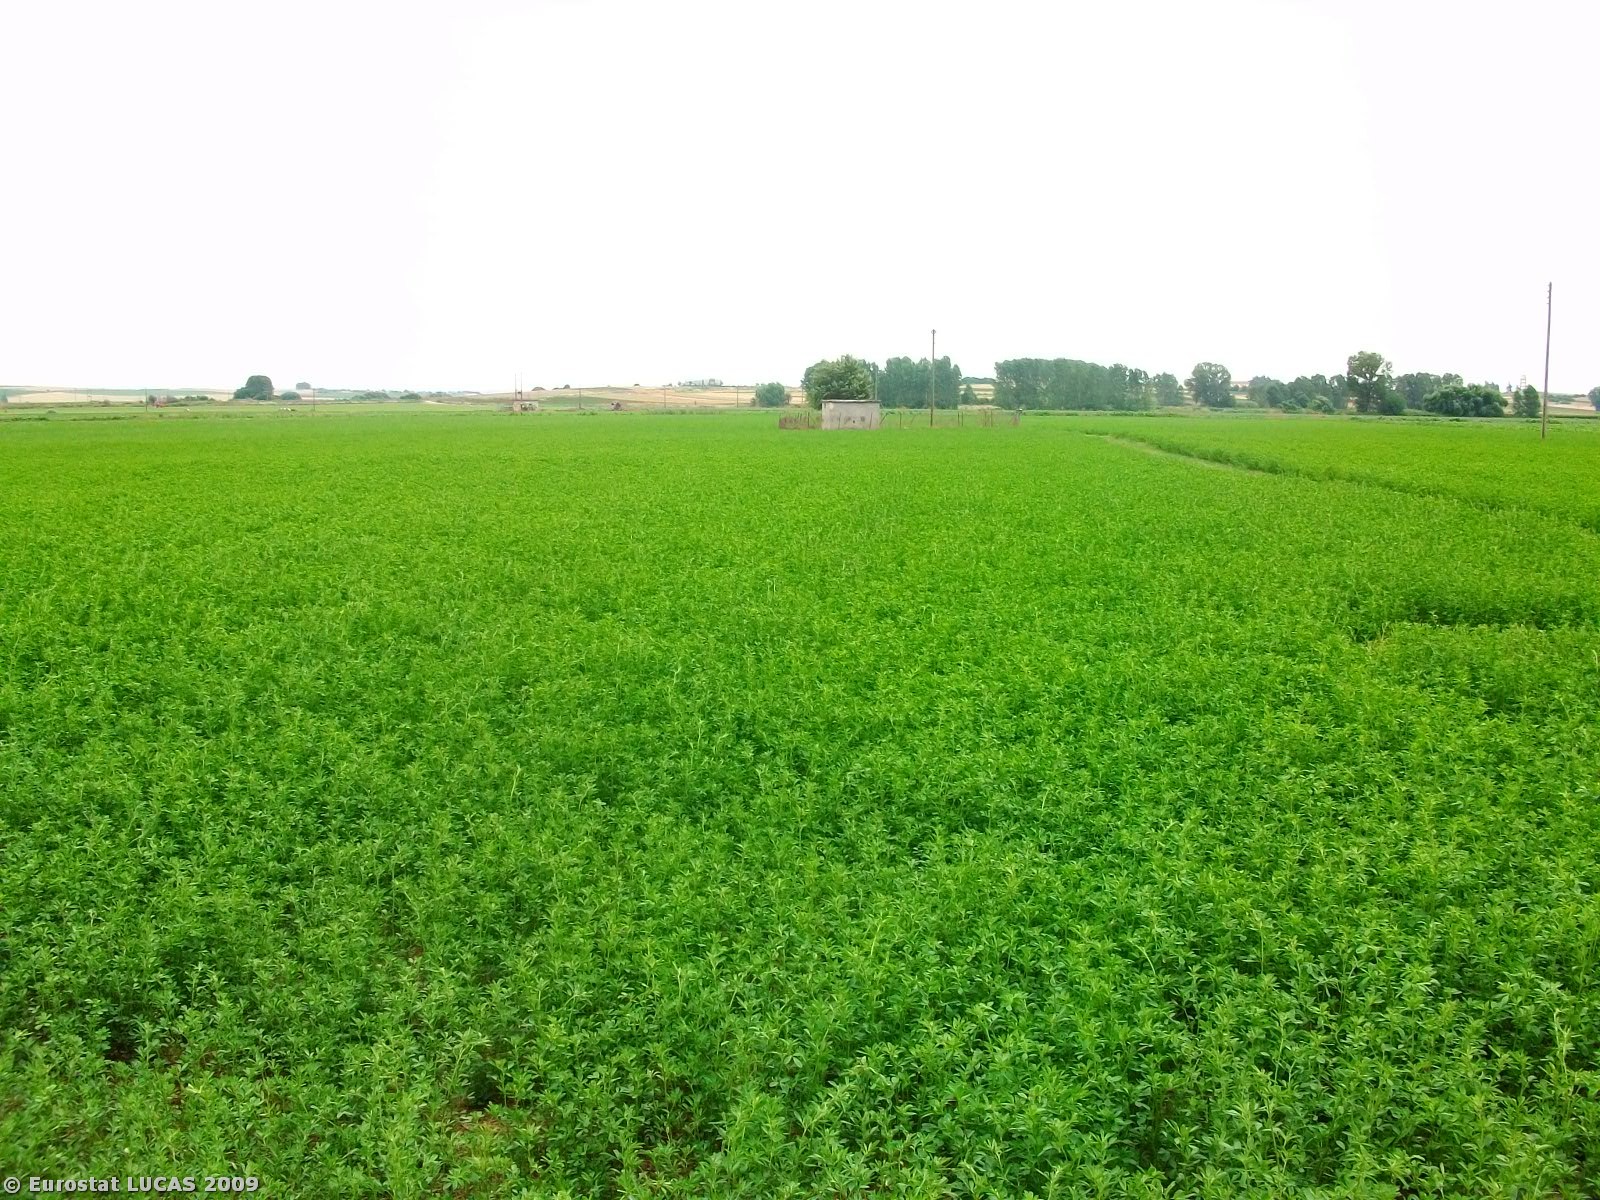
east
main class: Cropland
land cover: Clovers
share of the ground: > 75 %
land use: Agriculture (excluding fallow land and kitchen gardens)
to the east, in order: Clovers; Grass margins; Ditches and canals; Grass margins; Clovers; Grass margins; Clovers
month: June
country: GR
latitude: 41.0167
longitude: 23.6121
